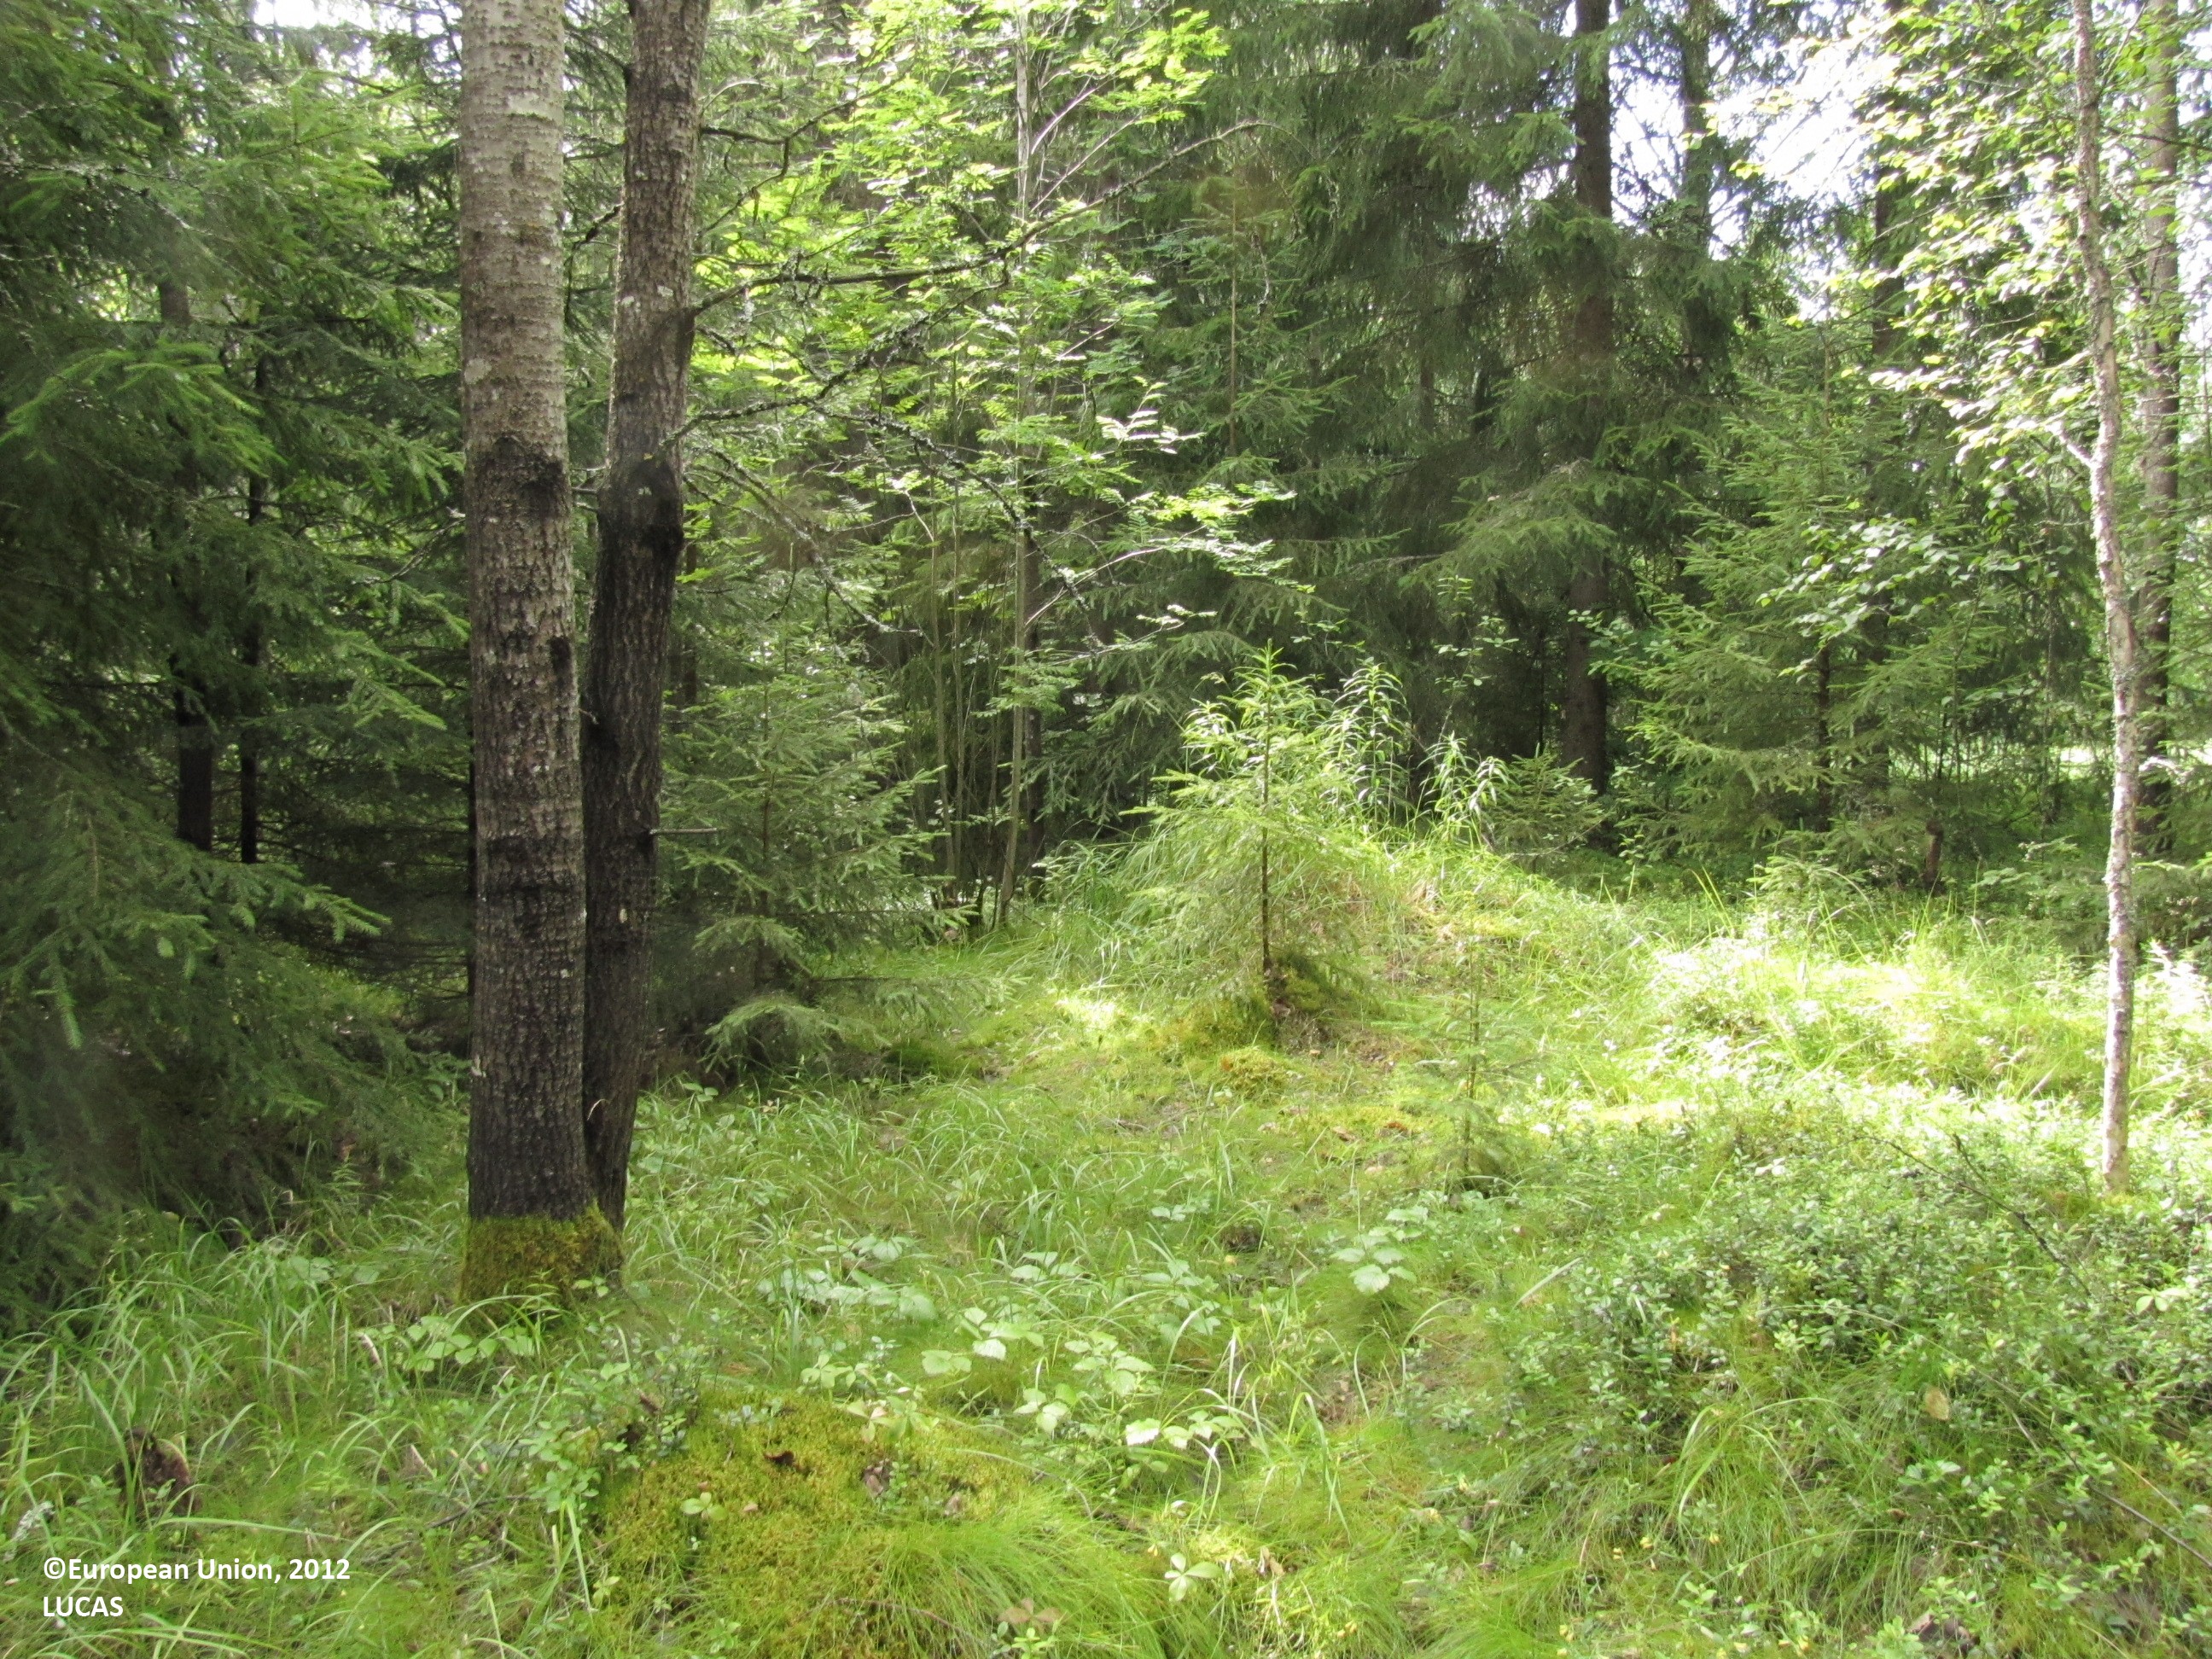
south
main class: Woodland
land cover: Other mixed woodland
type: boreal forest
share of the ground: 50 - 75 %
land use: Forestry
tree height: > 5 m
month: July
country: FI
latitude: 62.2499
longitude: 23.1782
